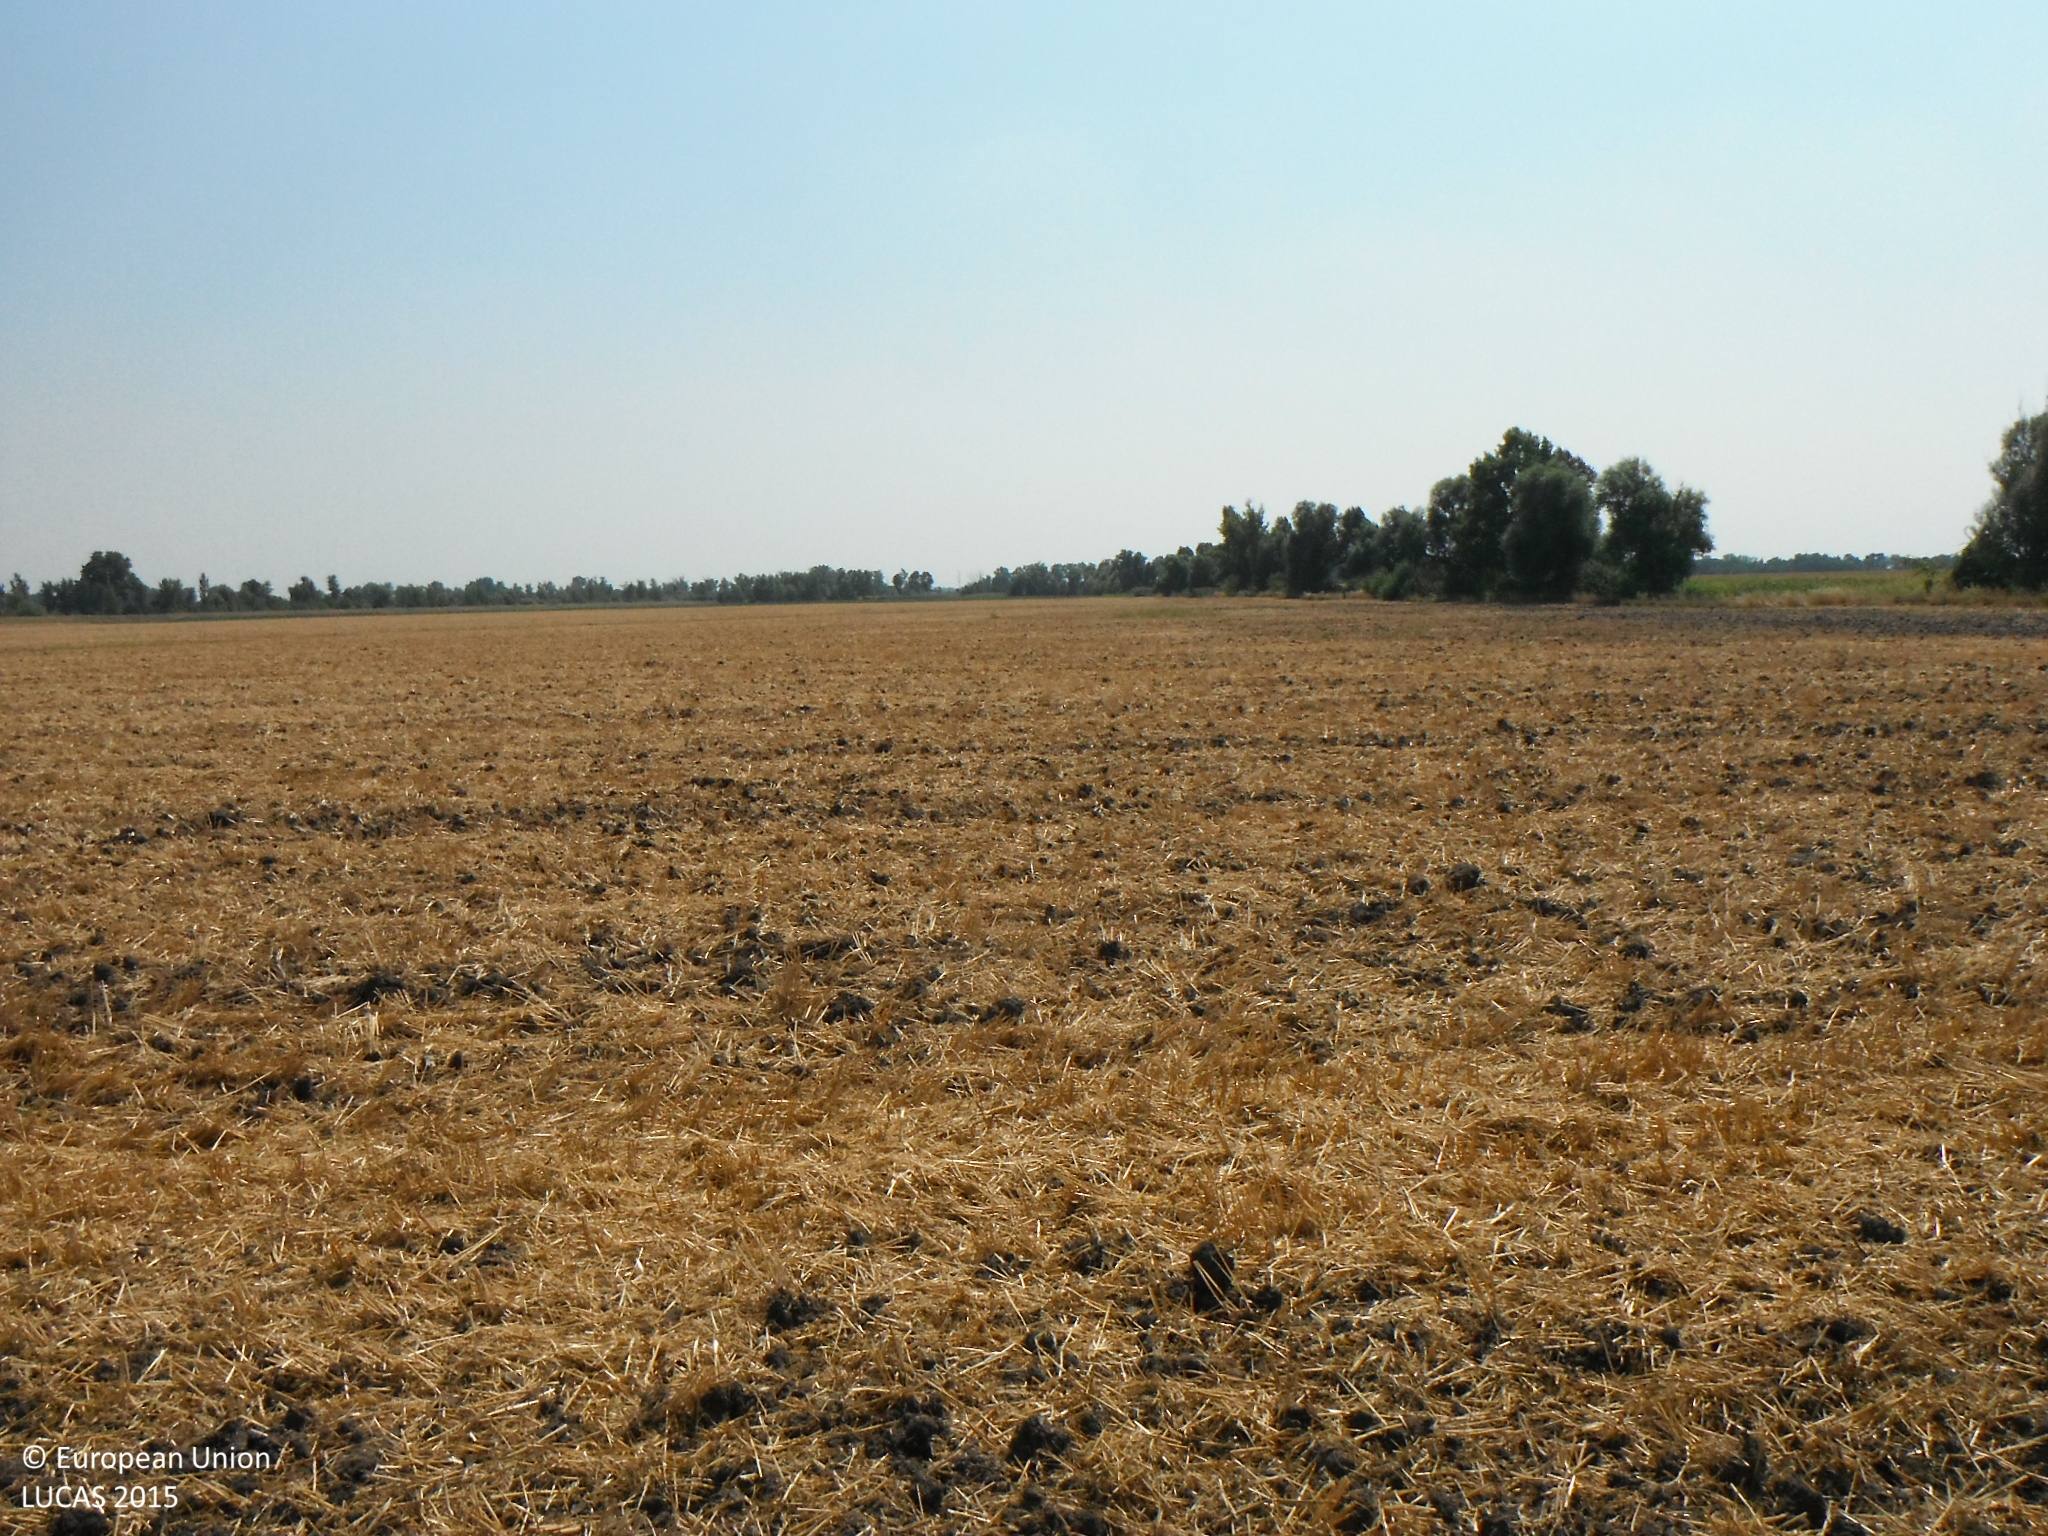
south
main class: Cropland
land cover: Common wheat
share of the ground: > 75 %
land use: Agriculture (excluding fallow land and kitchen gardens)
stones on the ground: < 10 %
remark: Harvested field
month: August
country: SK
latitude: 47.9880
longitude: 18.2275
